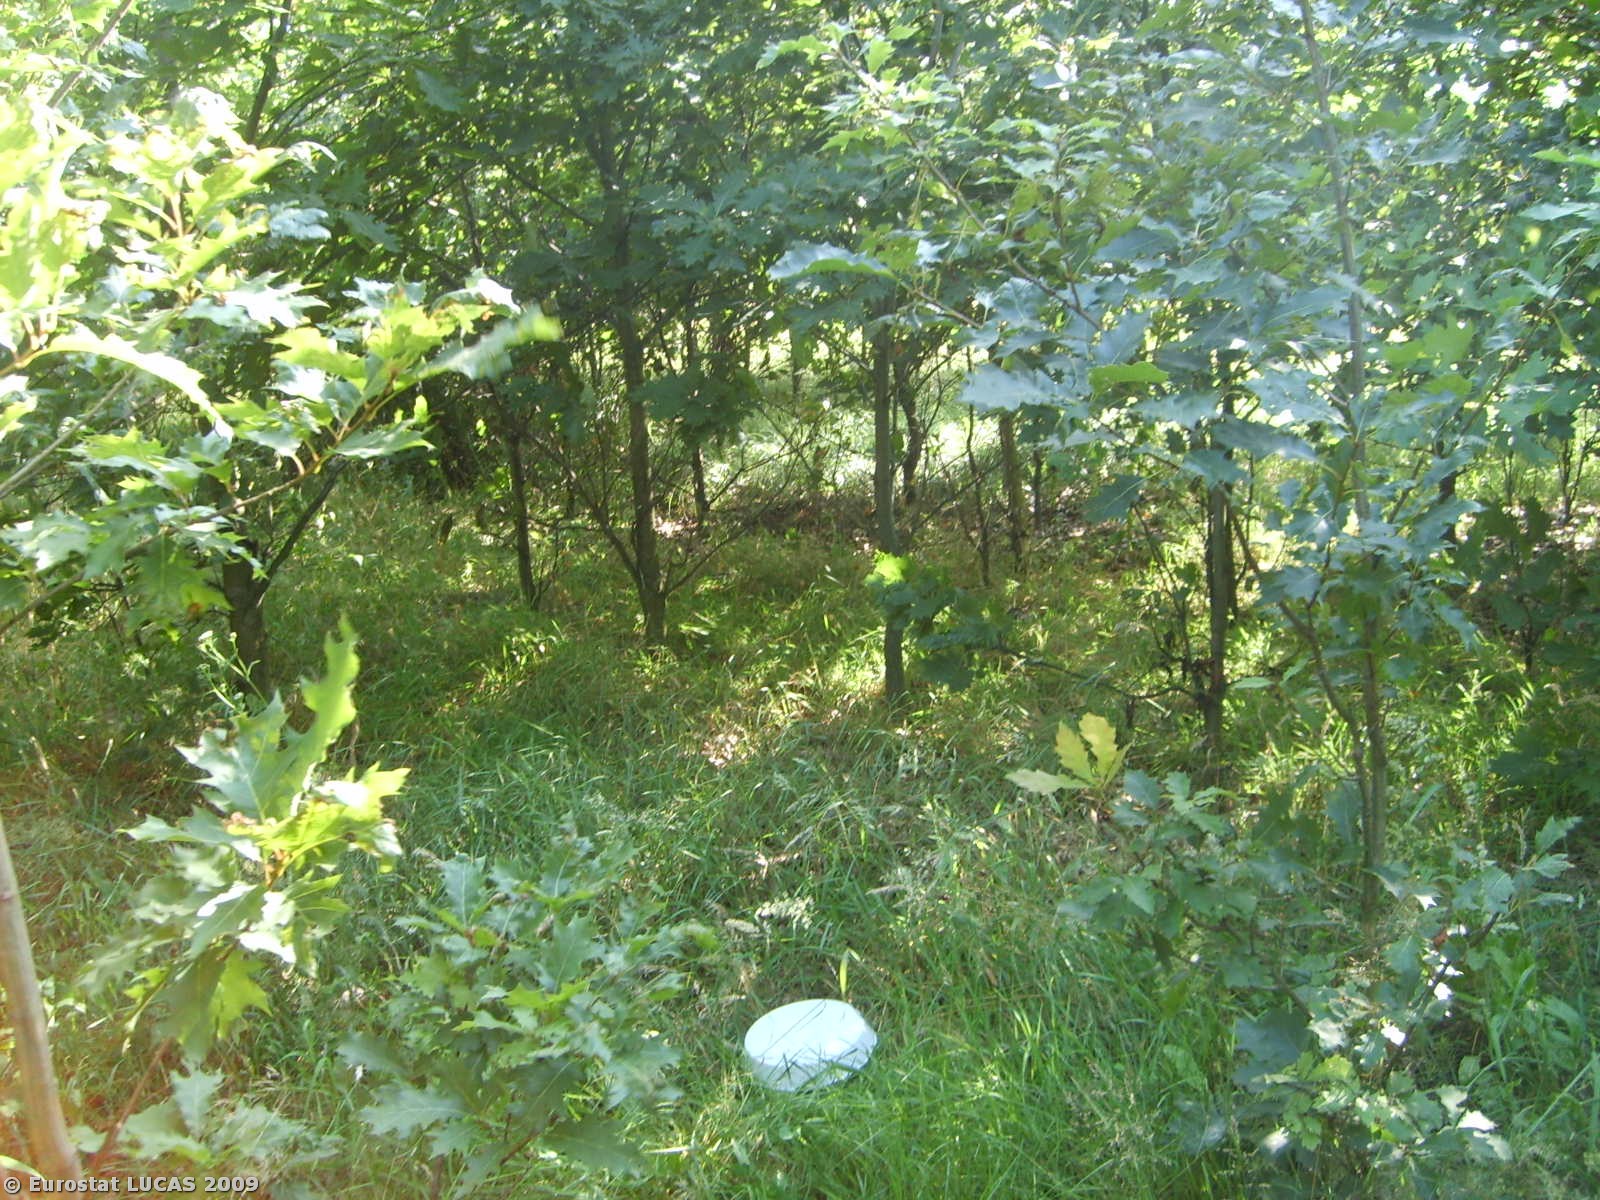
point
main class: Woodland
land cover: Broadleaved woodland
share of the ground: > 75 %
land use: Forestry
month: July
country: PL
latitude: 51.5937
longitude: 22.0843
